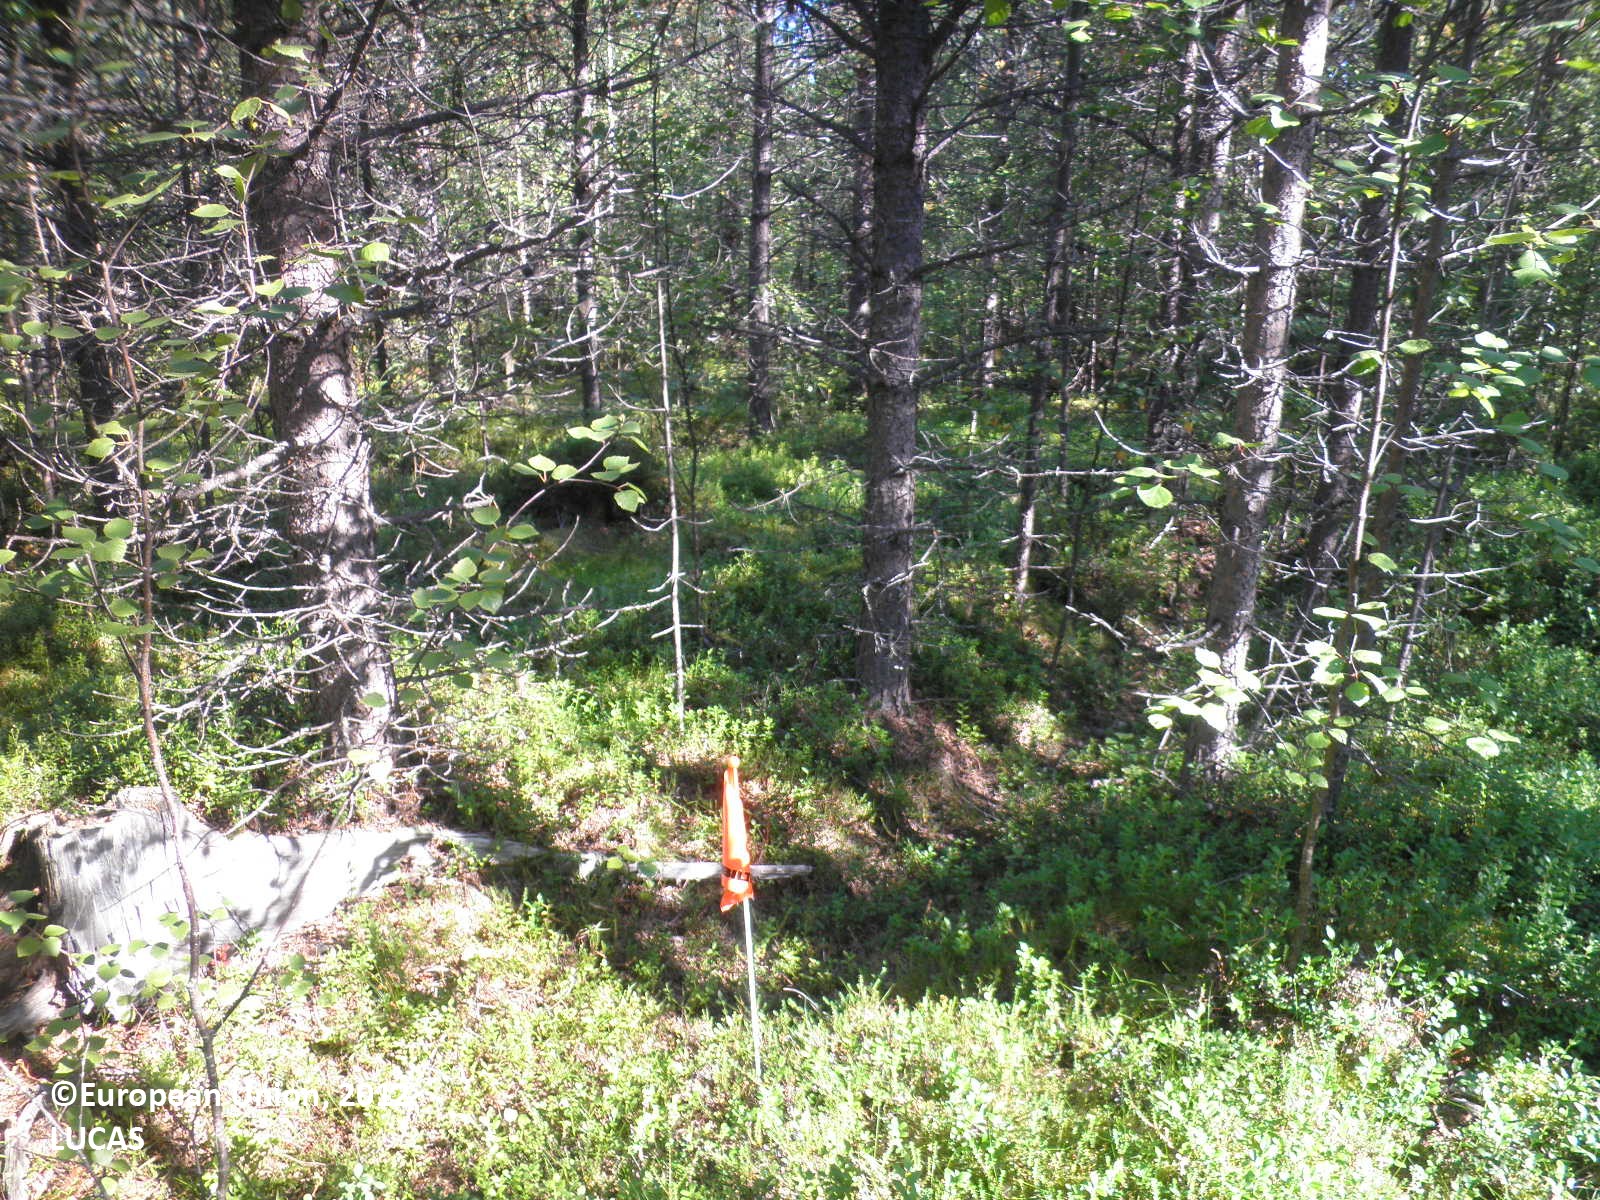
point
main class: Woodland
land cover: Pine dominated mixed woodland
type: boreal forest
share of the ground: 50 - 75 %
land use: Forestry
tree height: > 5 m
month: August
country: FI
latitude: 67.6556
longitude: 25.4372
